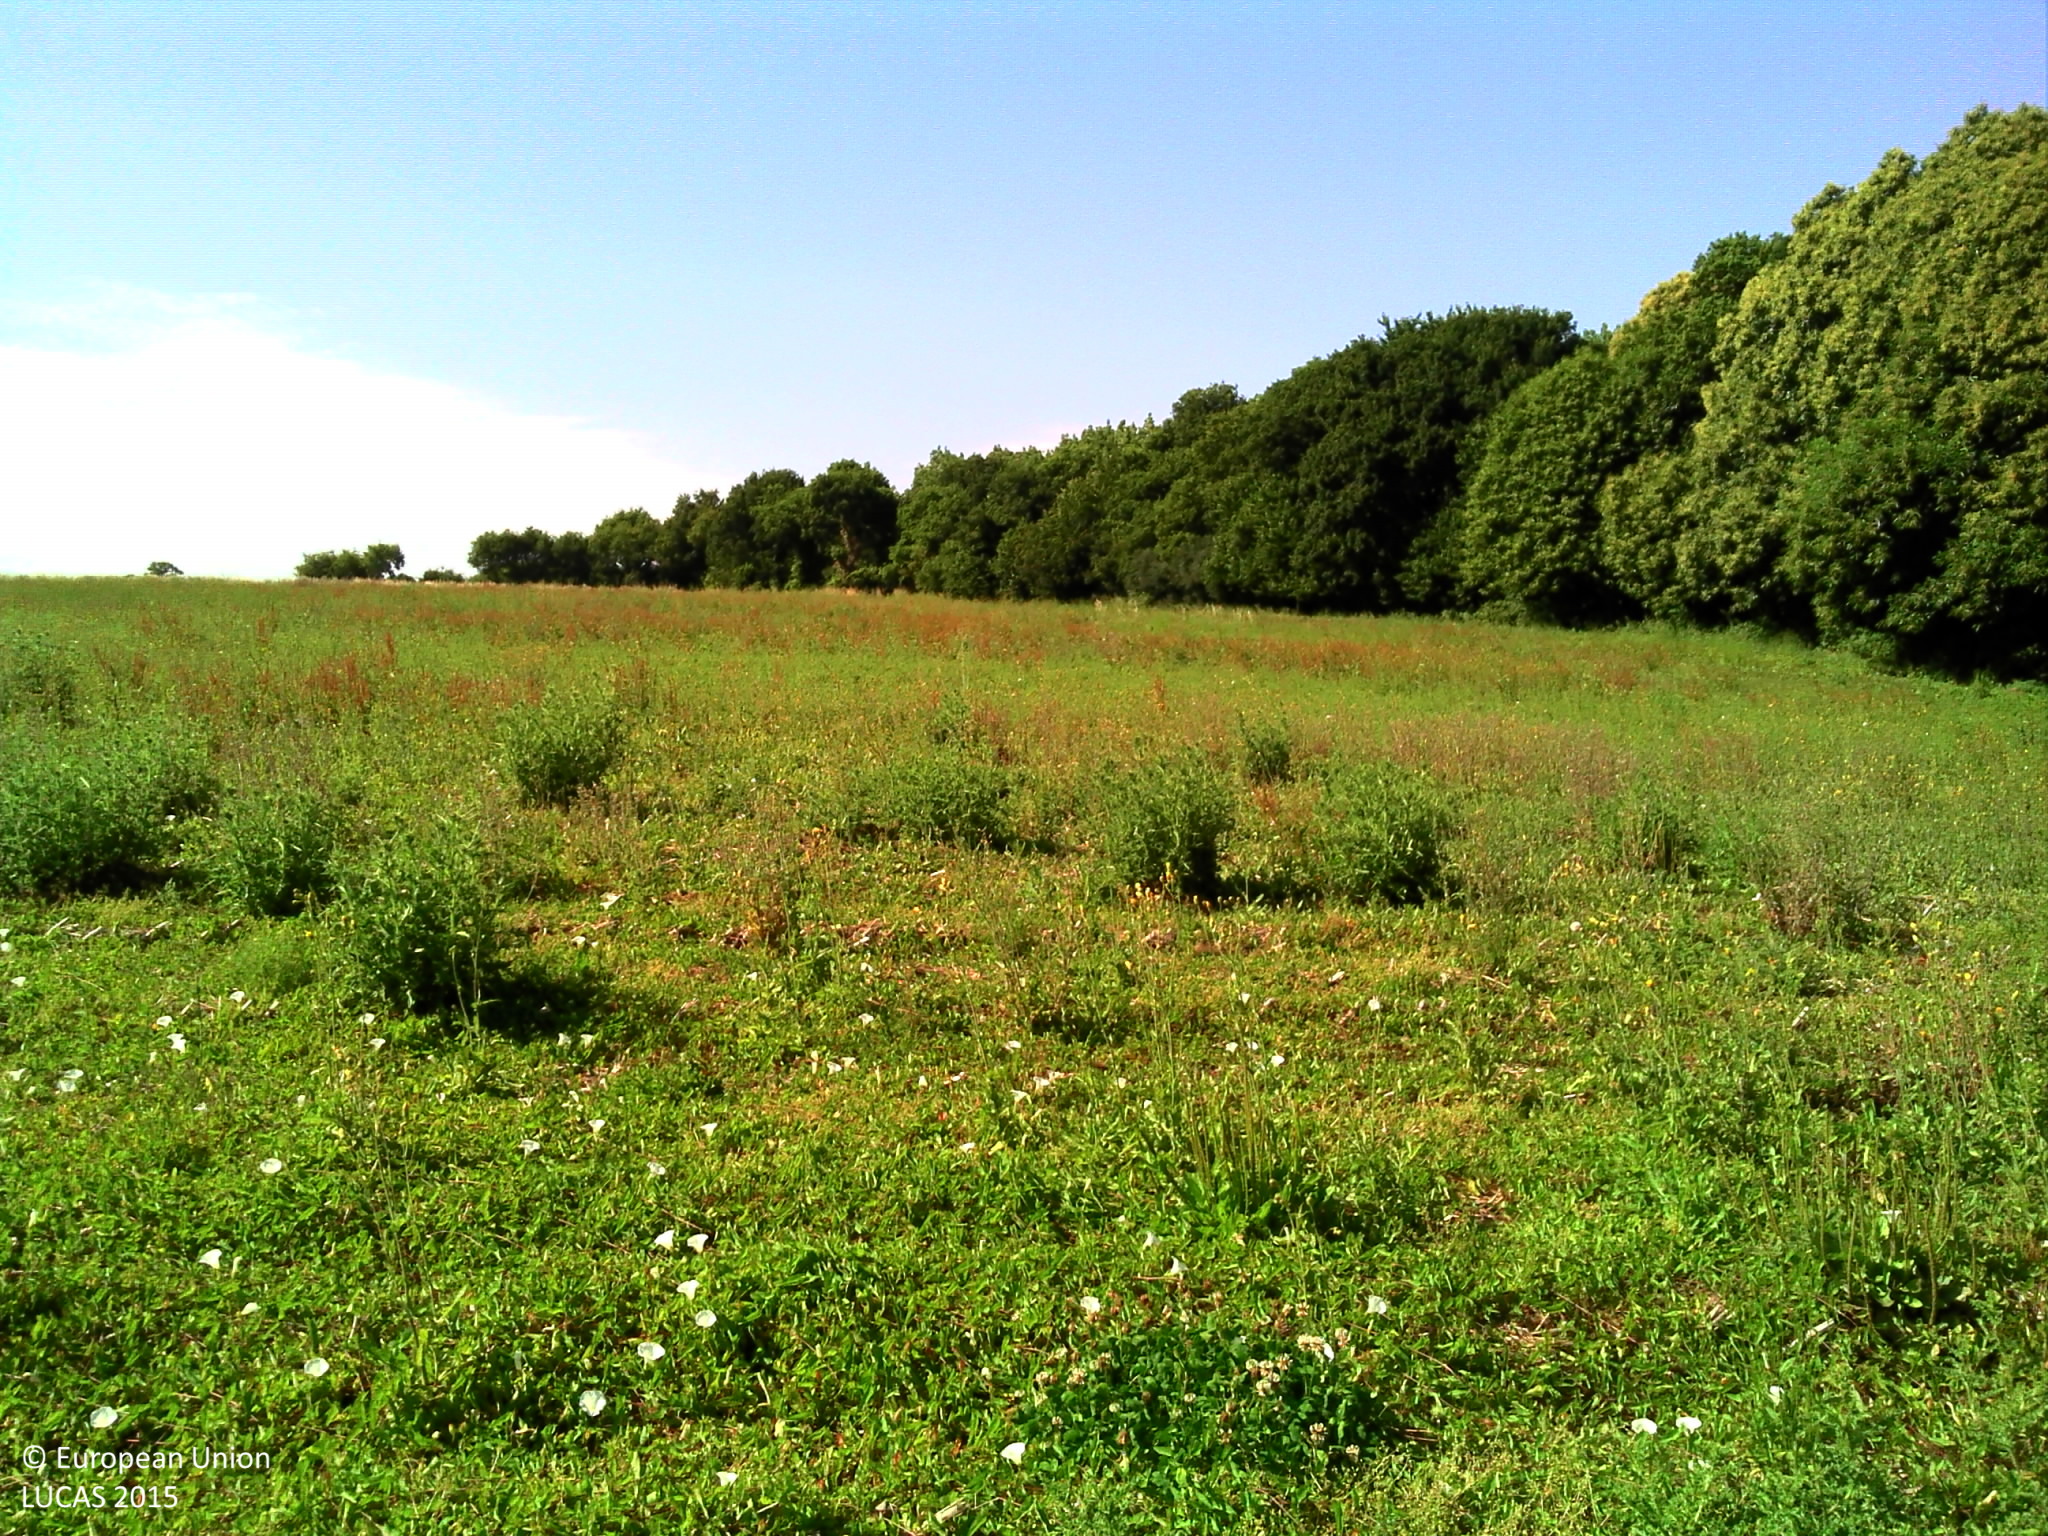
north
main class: Grassland
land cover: Spontaneously vegetated surfaces
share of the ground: > 75 %
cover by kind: herbaceous plants 90 %, unconsolidated bare surface 10 %
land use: Fallow land
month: July
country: FR
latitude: 48.3683
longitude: -2.4660
